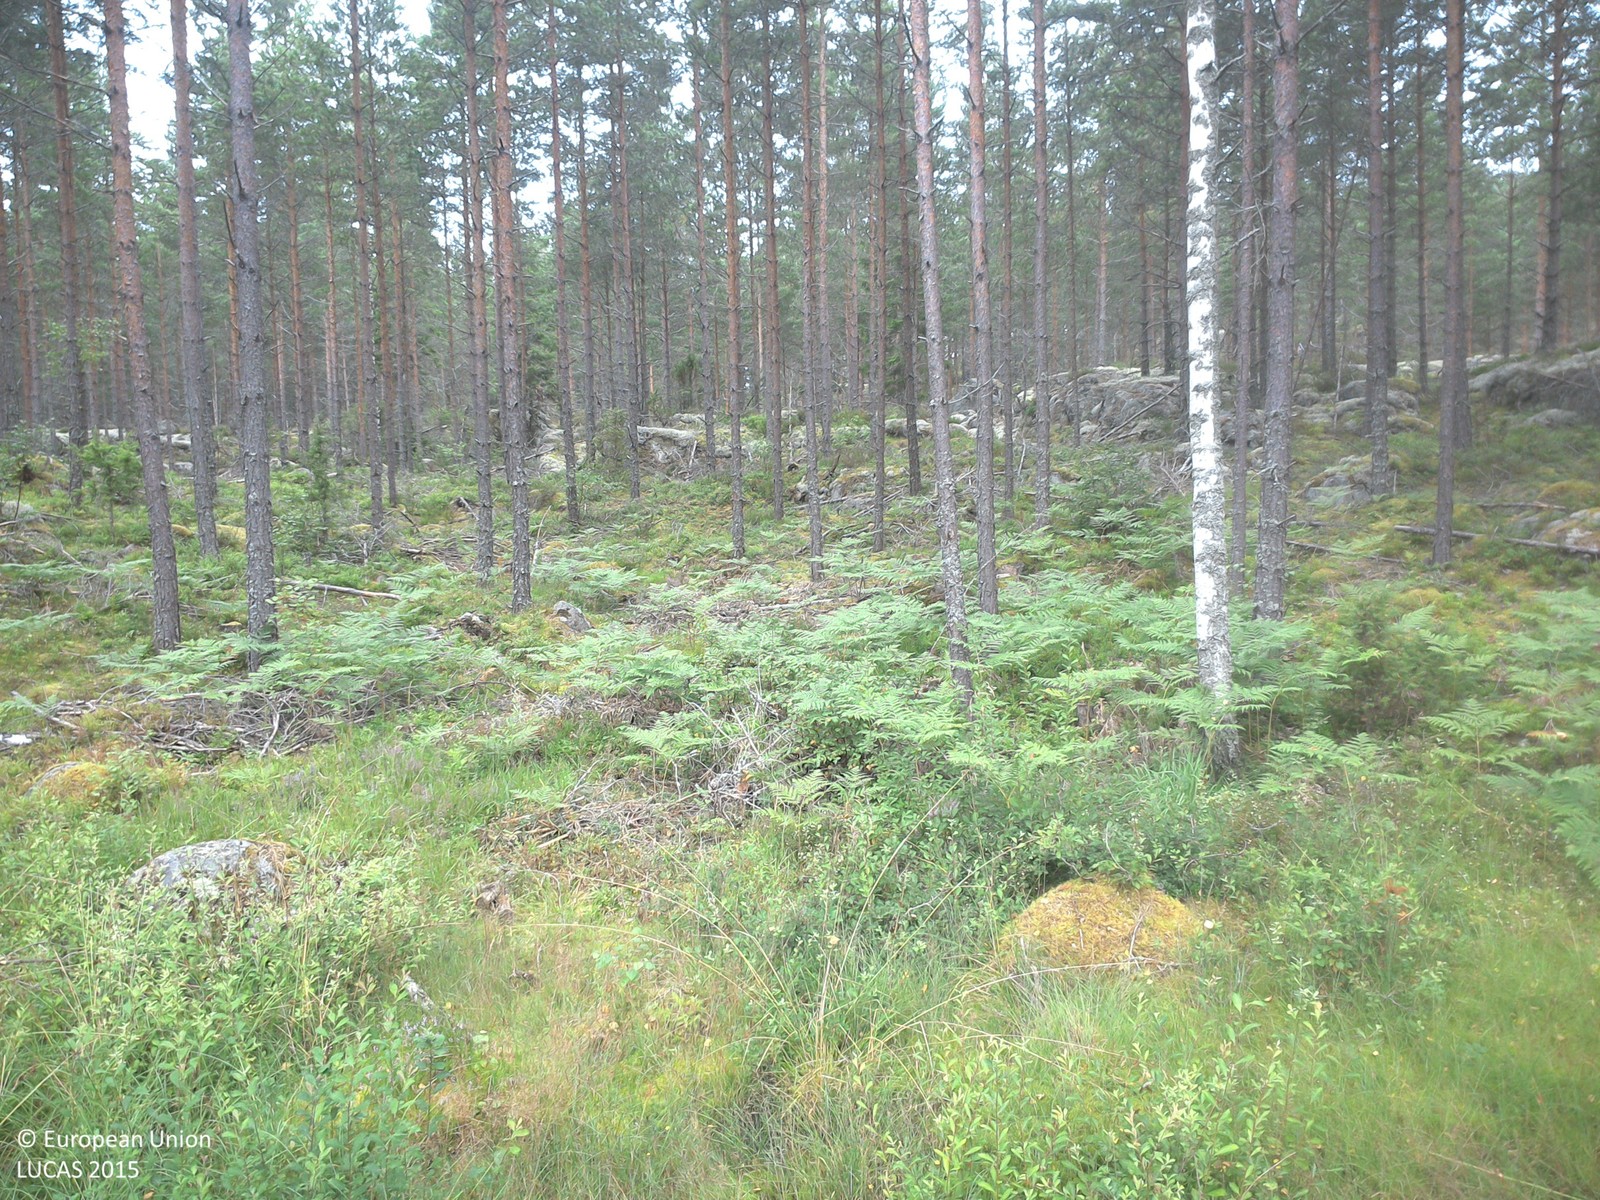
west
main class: Woodland
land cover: Pine dominated coniferous woodland
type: boreal forest
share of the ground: 10 - 25 %
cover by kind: herbaceous plants 45 %, lichens and mosses 30 %, coniferous forest trees 25 %
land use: Forestry
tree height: > 5 m
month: August
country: SE
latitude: 57.8060
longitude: 15.3641
